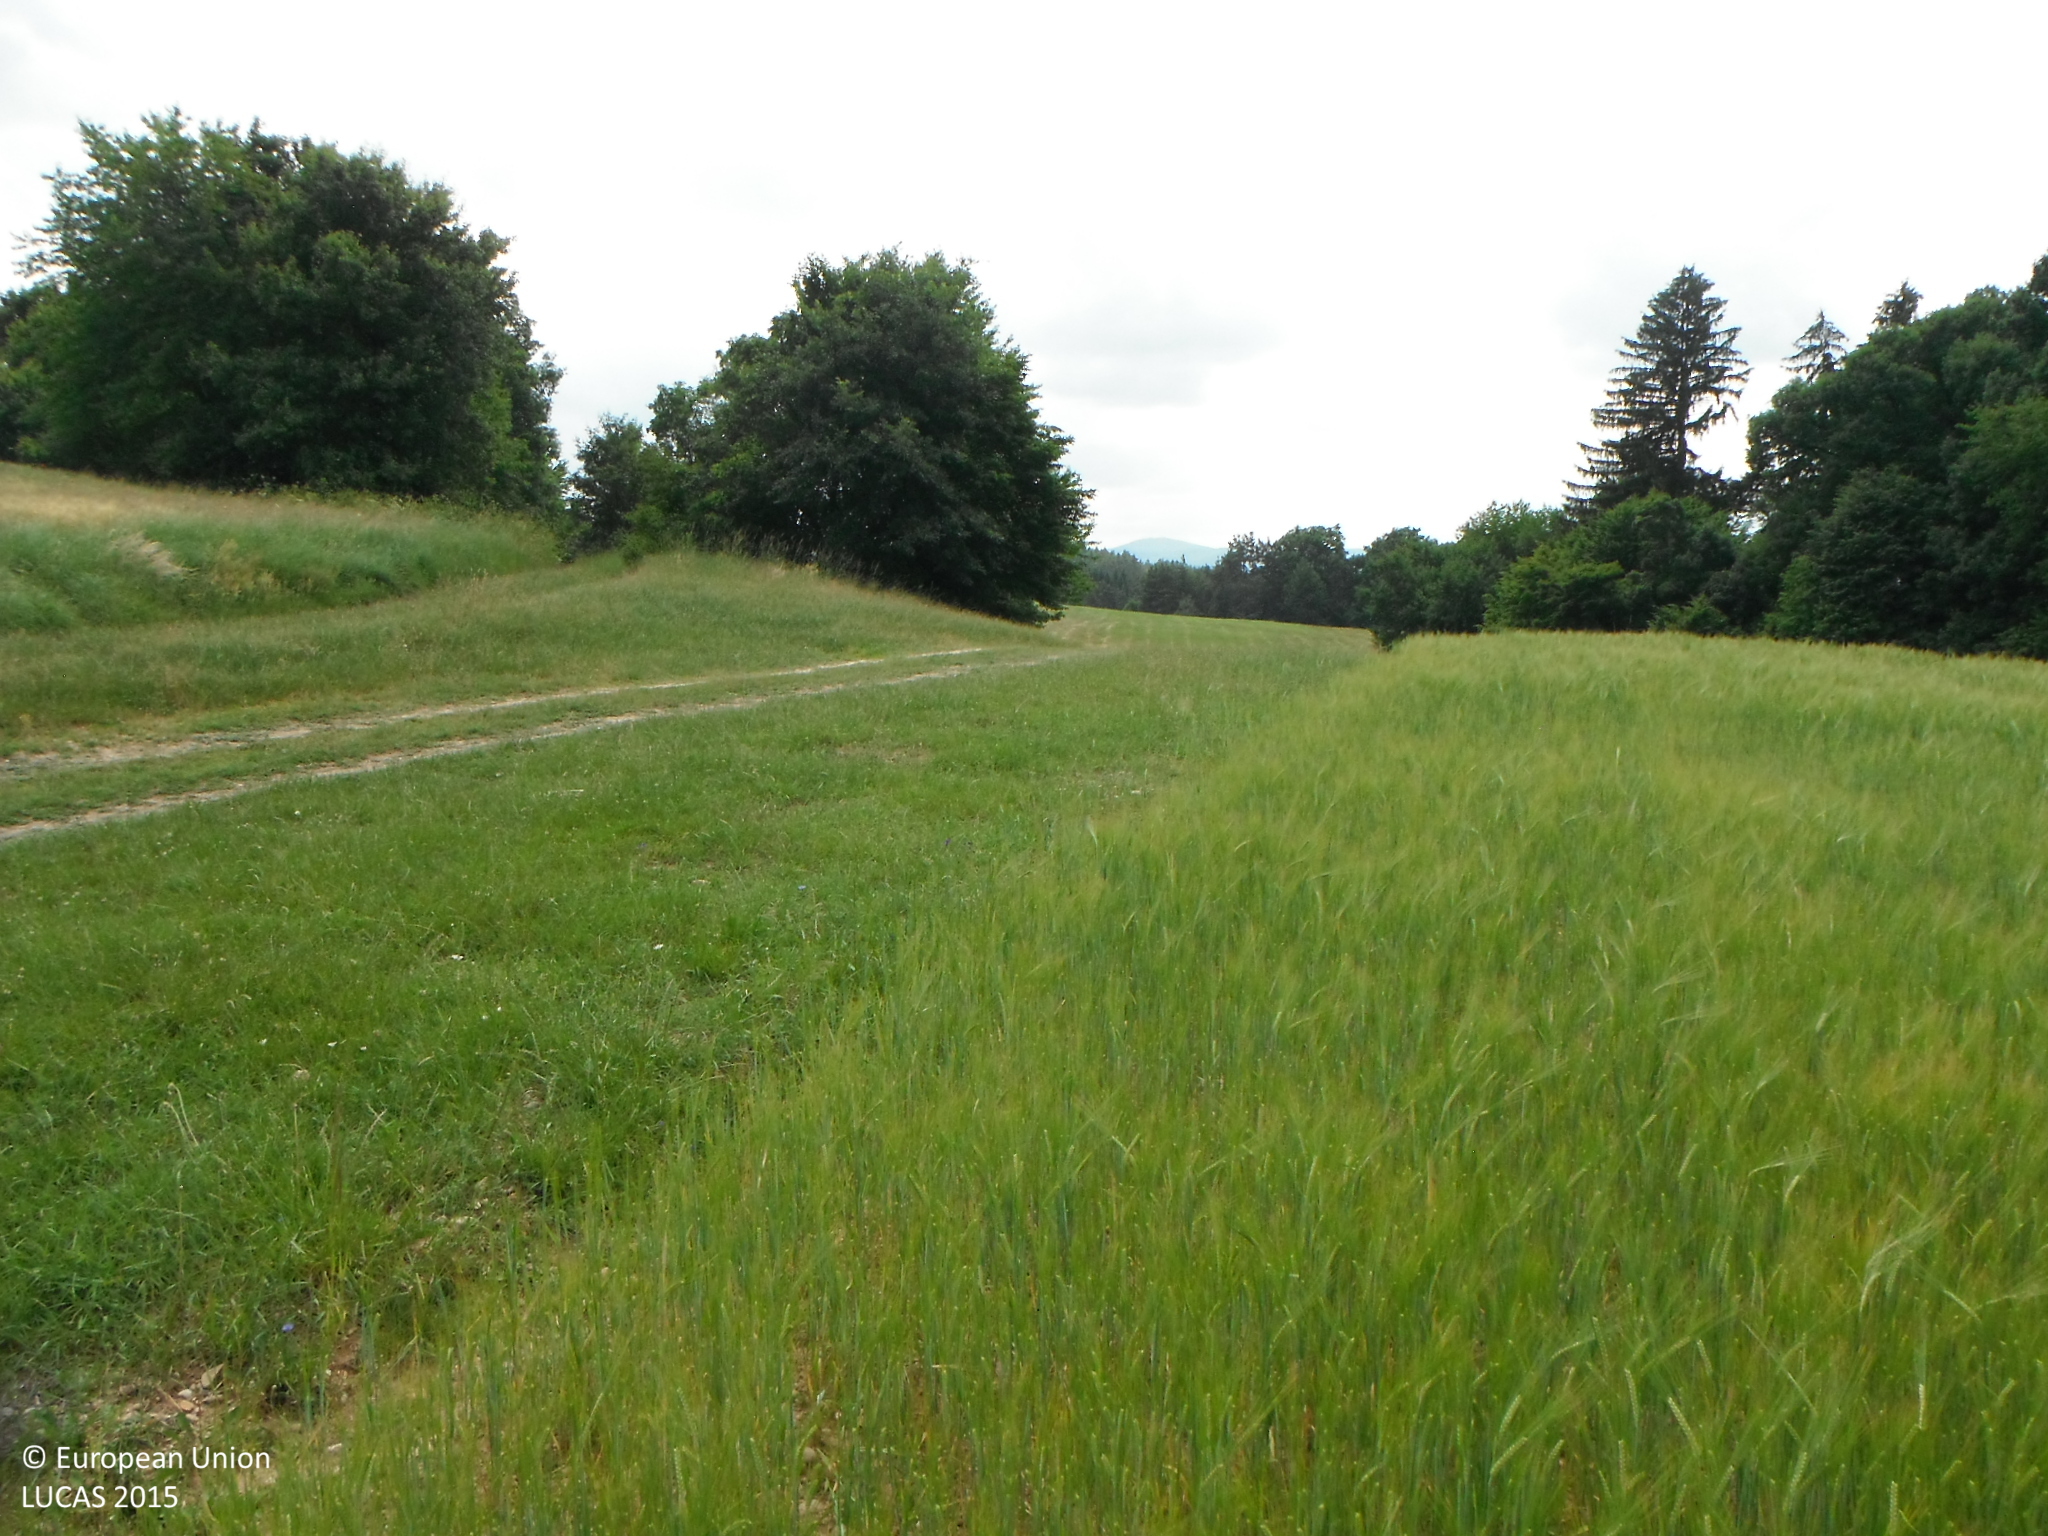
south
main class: Cropland
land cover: Barley
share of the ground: > 75 %
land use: Agriculture (excluding fallow land and kitchen gardens)
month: June
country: SK
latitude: 48.6185
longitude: 19.1790
